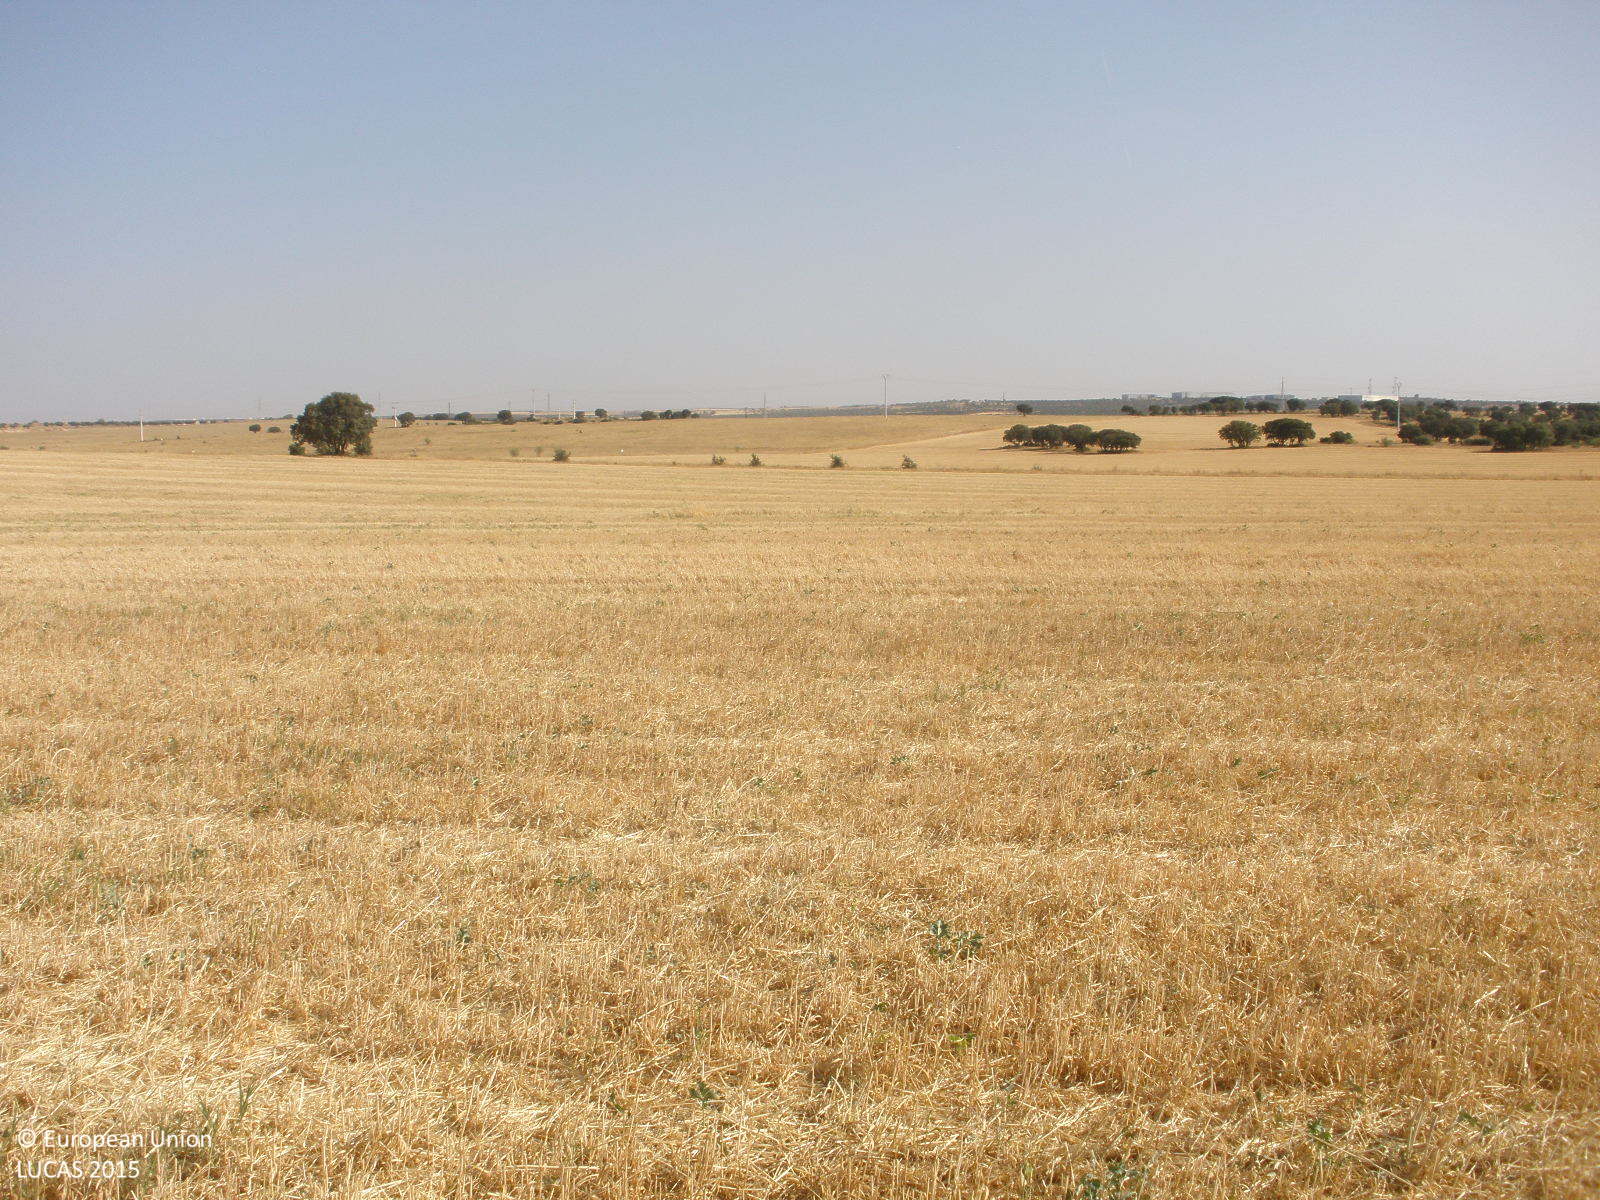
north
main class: Cropland
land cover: Barley
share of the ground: < 10 %
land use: Agriculture (excluding fallow land and kitchen gardens)
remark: Harvested field
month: July
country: ES
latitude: 40.2507
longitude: -3.3271
